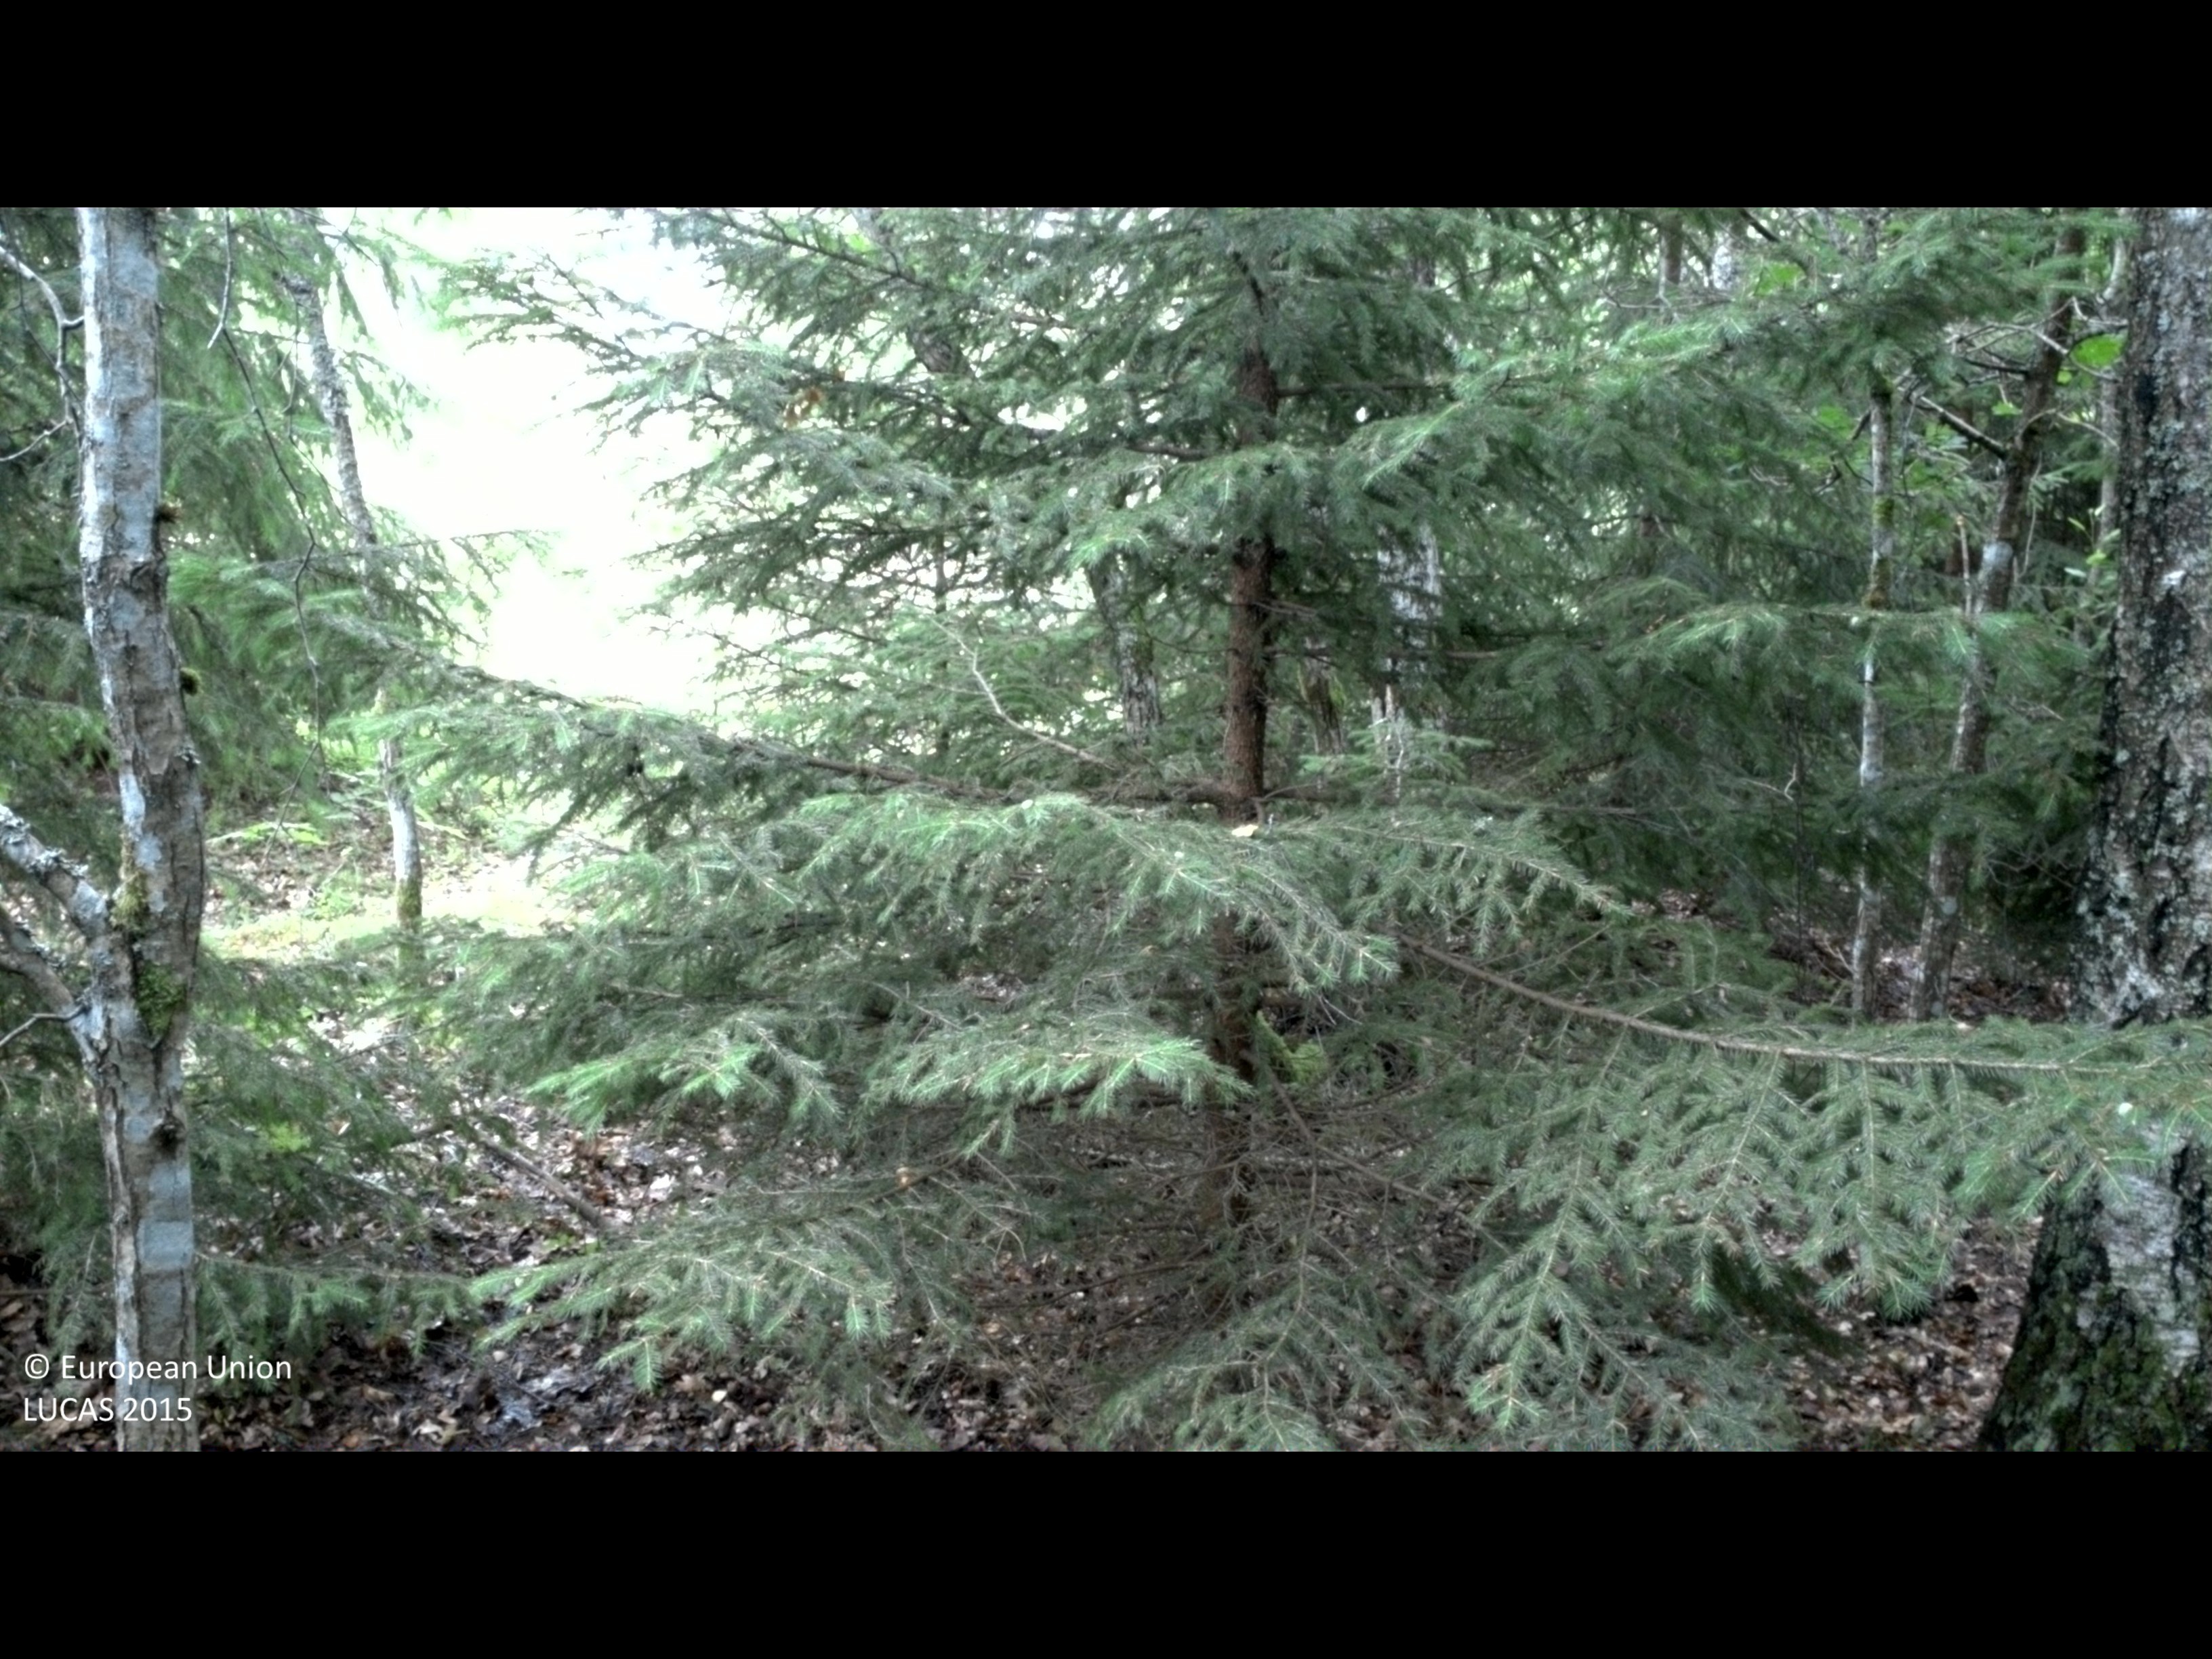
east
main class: Woodland
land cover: Spruce dominated mixed woodland
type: boreal forest
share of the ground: > 75 %
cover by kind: coniferous forest trees 40 %, broadleaved forest trees 40 %, shrubs 15 %, herbaceous plants 5 %
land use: Forestry
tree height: > 5 m
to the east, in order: Spruce dominated mixed woodland; Broadleaved woodland; Spruce dominated mixed woodland; Spruce dominated coniferous woodland; Spruce dominated mixed woodland; Broadleaved woodland; Spruce dominated mixed woodland
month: July
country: SE
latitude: 58.1503
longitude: 16.1639
